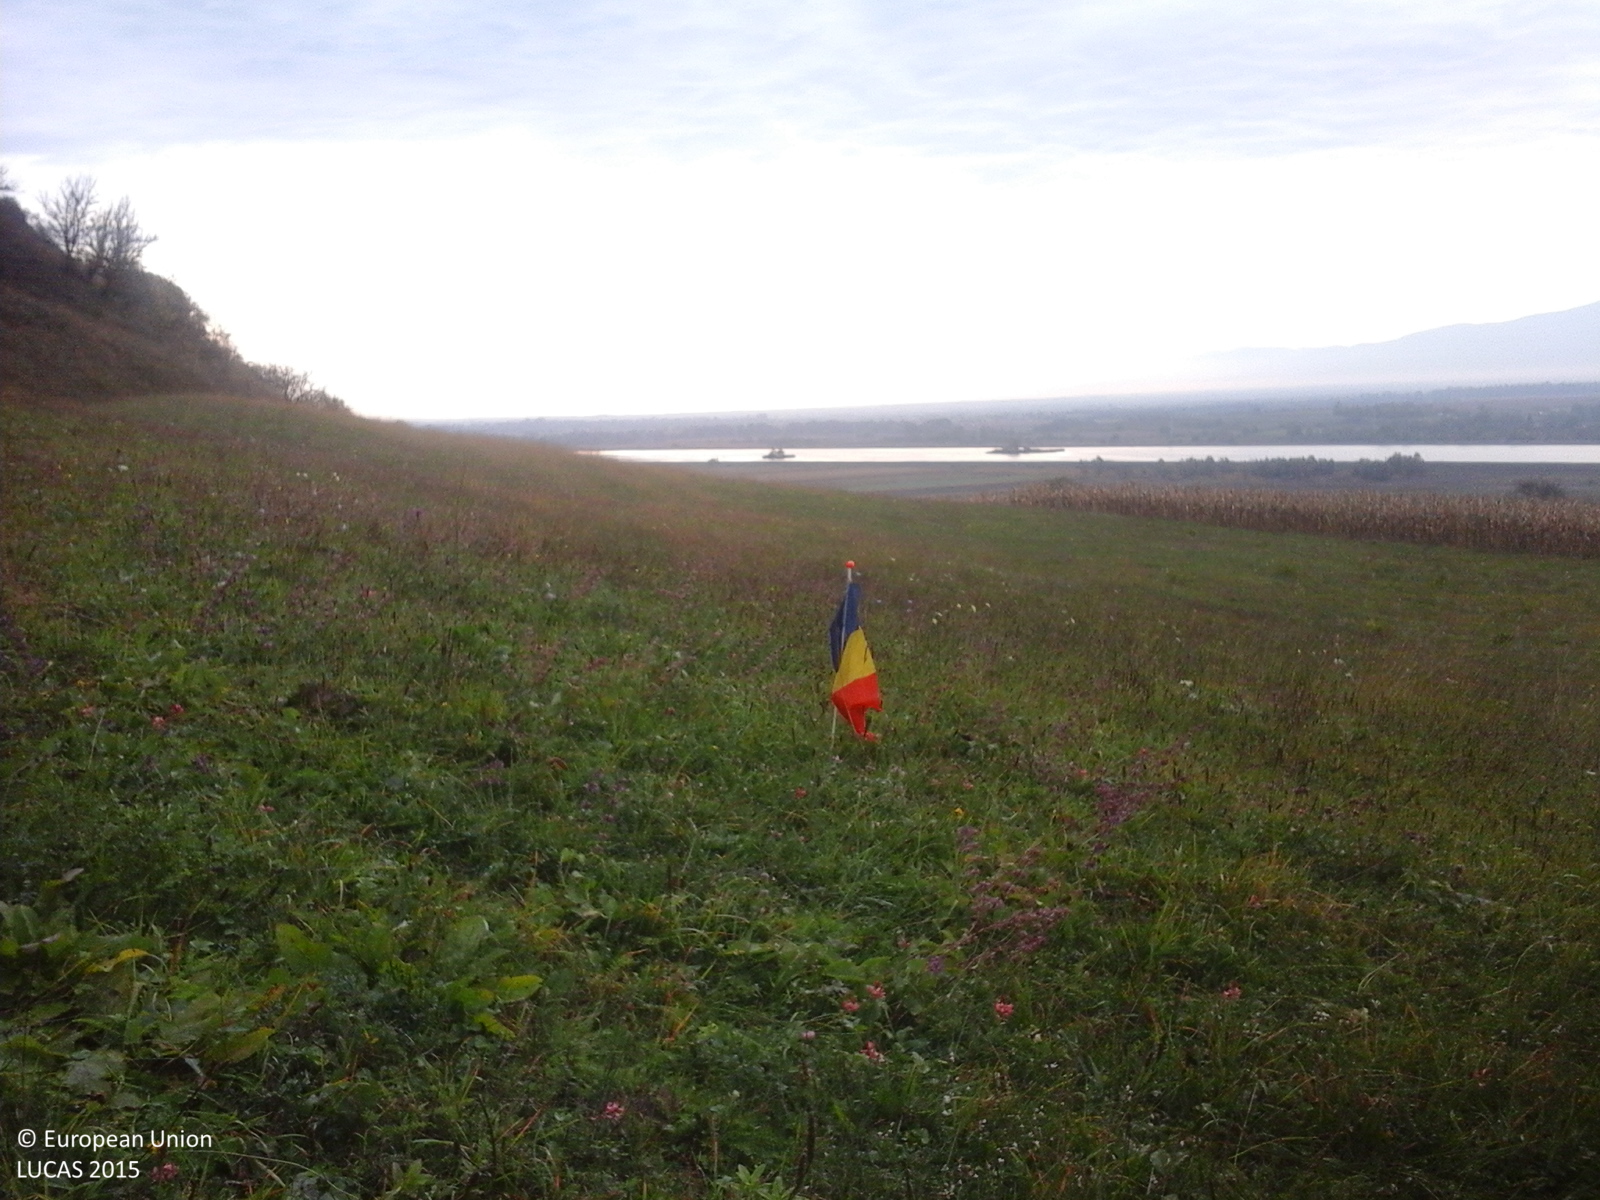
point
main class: Grassland
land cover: Grassland without tree/shrub cover
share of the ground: > 75 %
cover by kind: herbaceous plants 100 %
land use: Agriculture (excluding fallow land and kitchen gardens)
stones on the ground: < 10 %
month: October
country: RO
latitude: 45.8163
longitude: 24.7457
